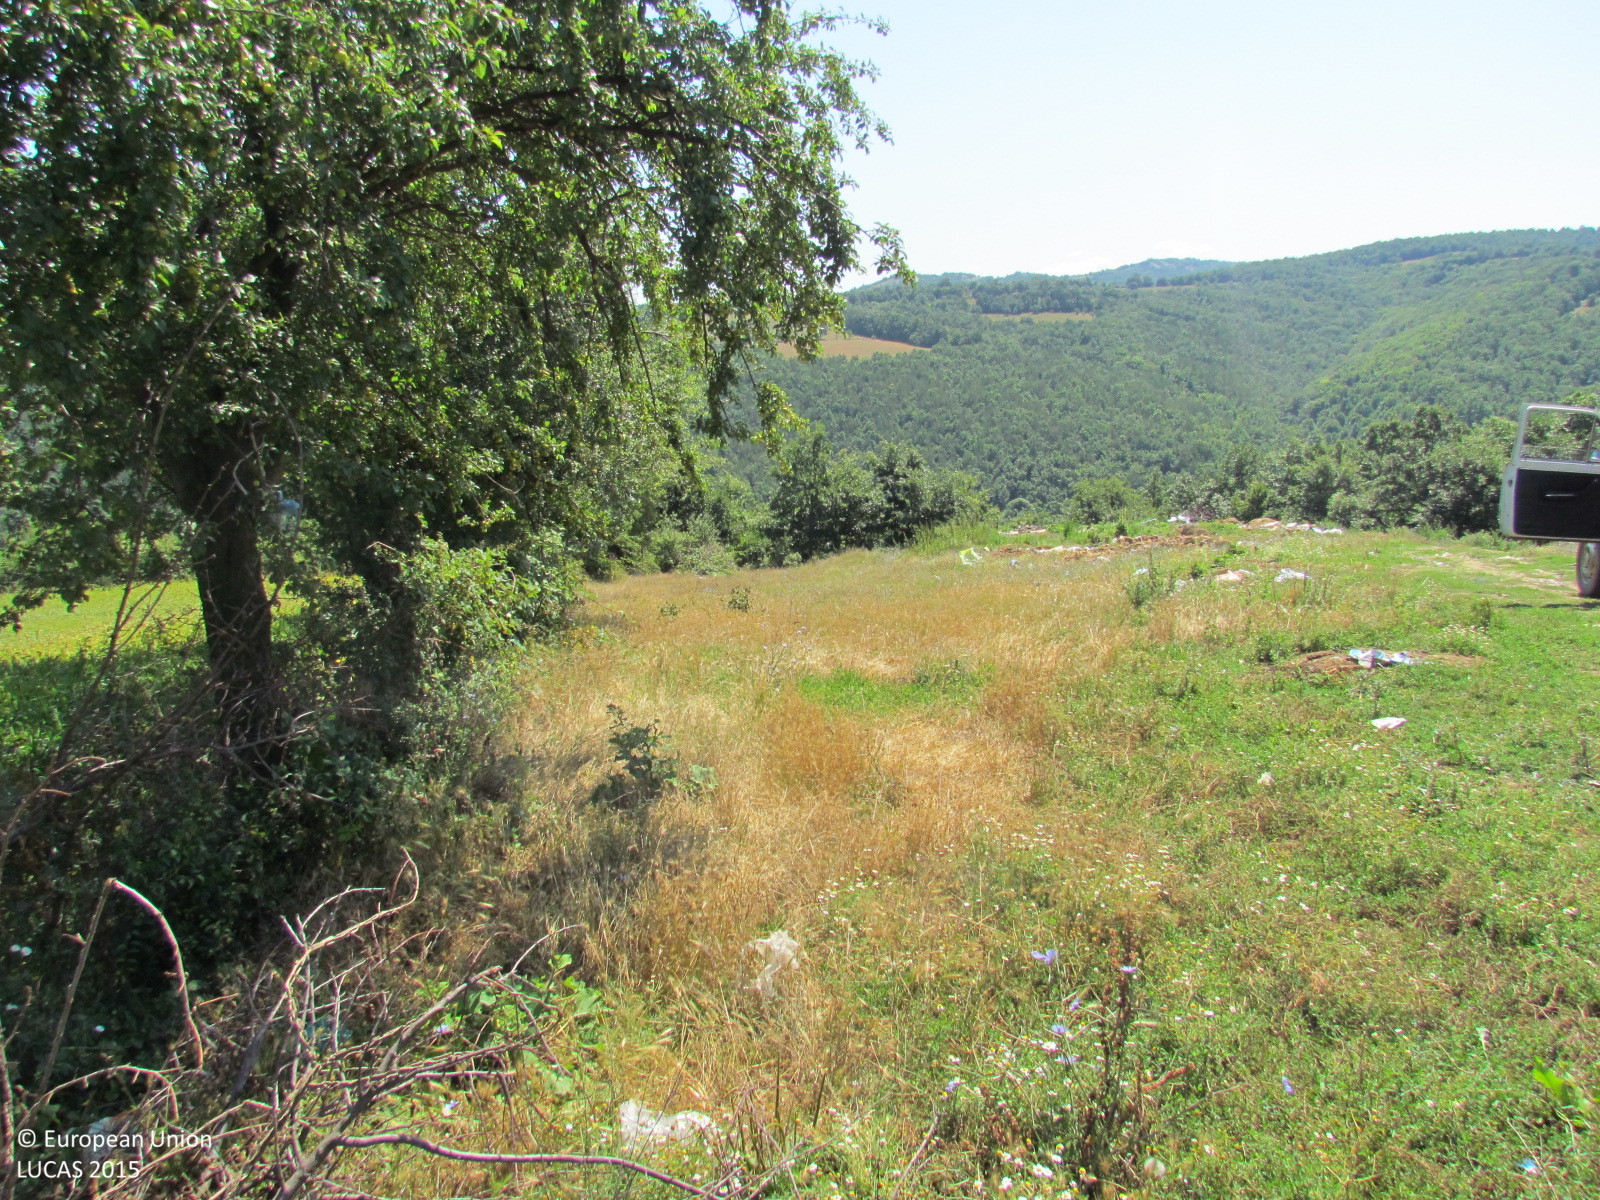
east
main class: Cropland
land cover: Common wheat
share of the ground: > 75 %
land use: Agriculture (excluding fallow land and kitchen gardens)
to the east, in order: Common wheat; Fences; Grass margins; Grassland without tree/shrub cover; Abandoned hedges; Grassland without tree/shrub cover; Single bushes/trees; Grassland without tree/shrub cover; Abandoned hedges; Grassland without tree/shrub cover; Abandoned hedges; Grassland without tree/shrub cover; Abandoned hedges; Grassland without tree/shrub cover; Abandoned hedges; Grassland without tree/shrub cover; Tracks; Maize
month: July
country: BG
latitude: 42.8640
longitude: 27.4152
